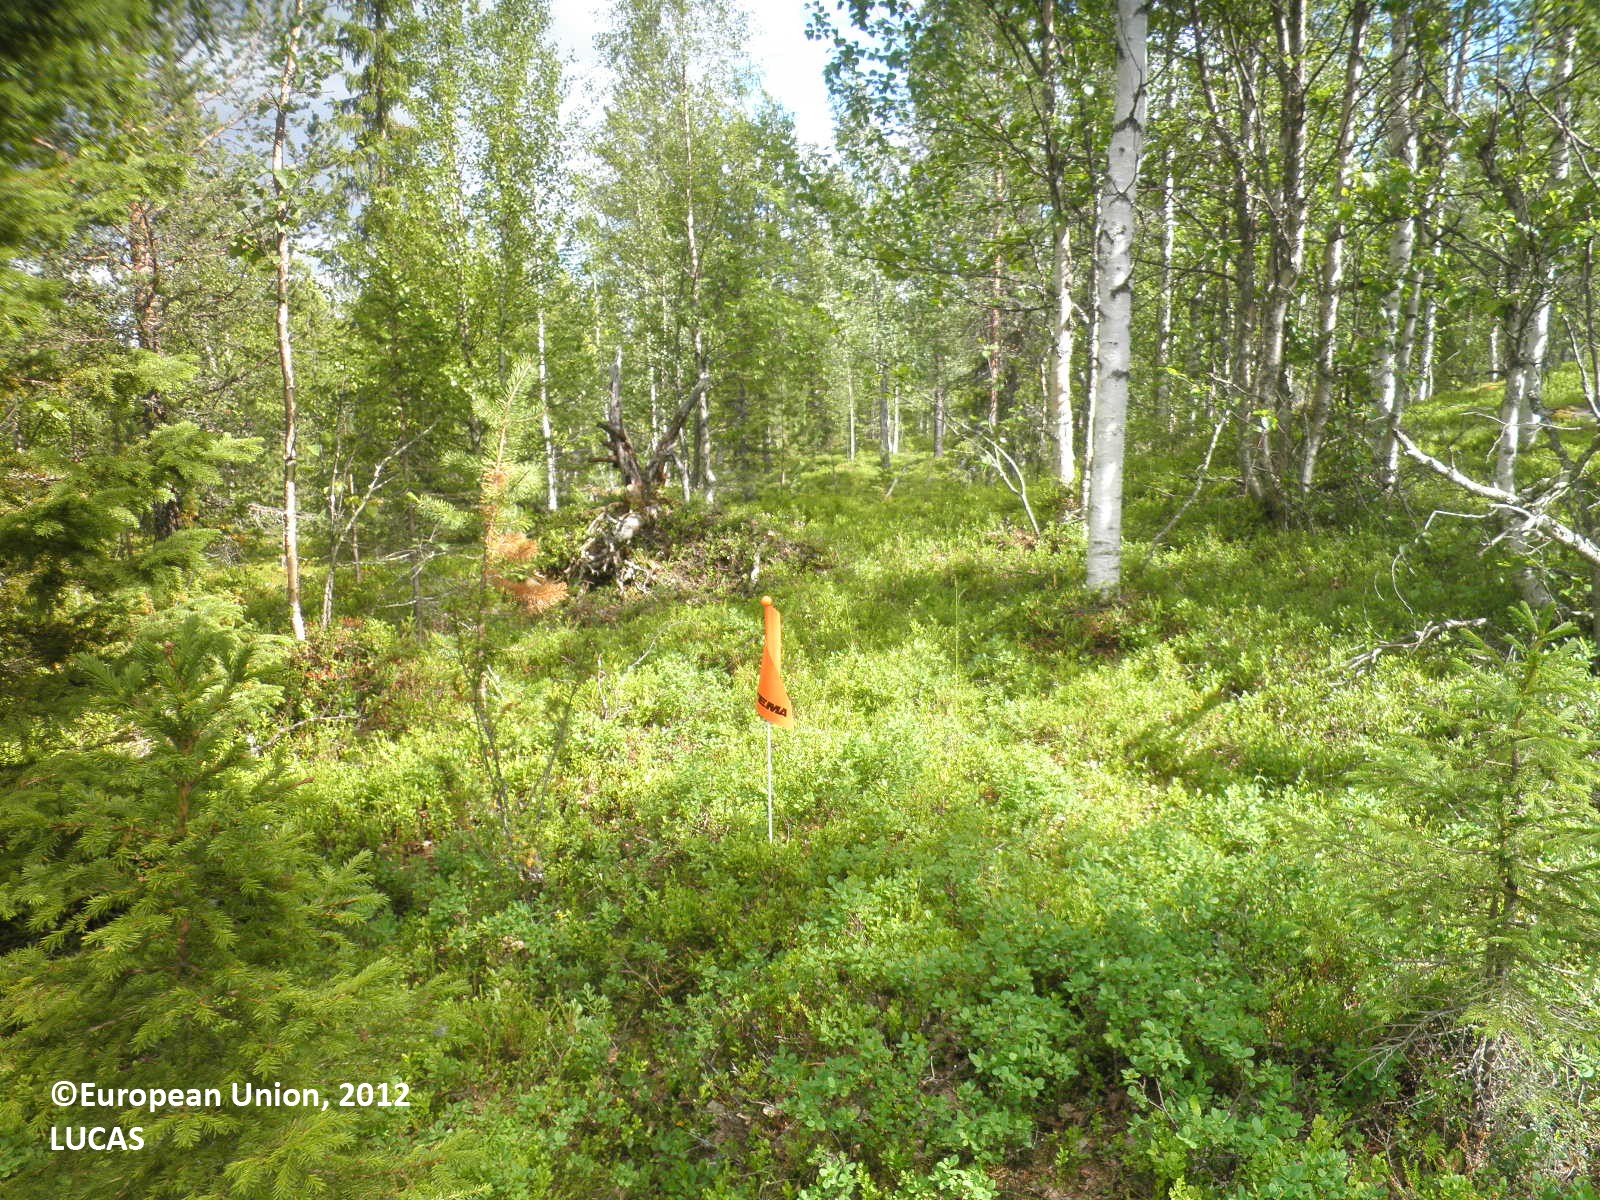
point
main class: Woodland
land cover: Spruce dominated mixed woodland
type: boreal forest
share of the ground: 50 - 75 %
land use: Forestry
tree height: > 5 m
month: July
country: FI
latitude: 67.6541
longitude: 25.8695
